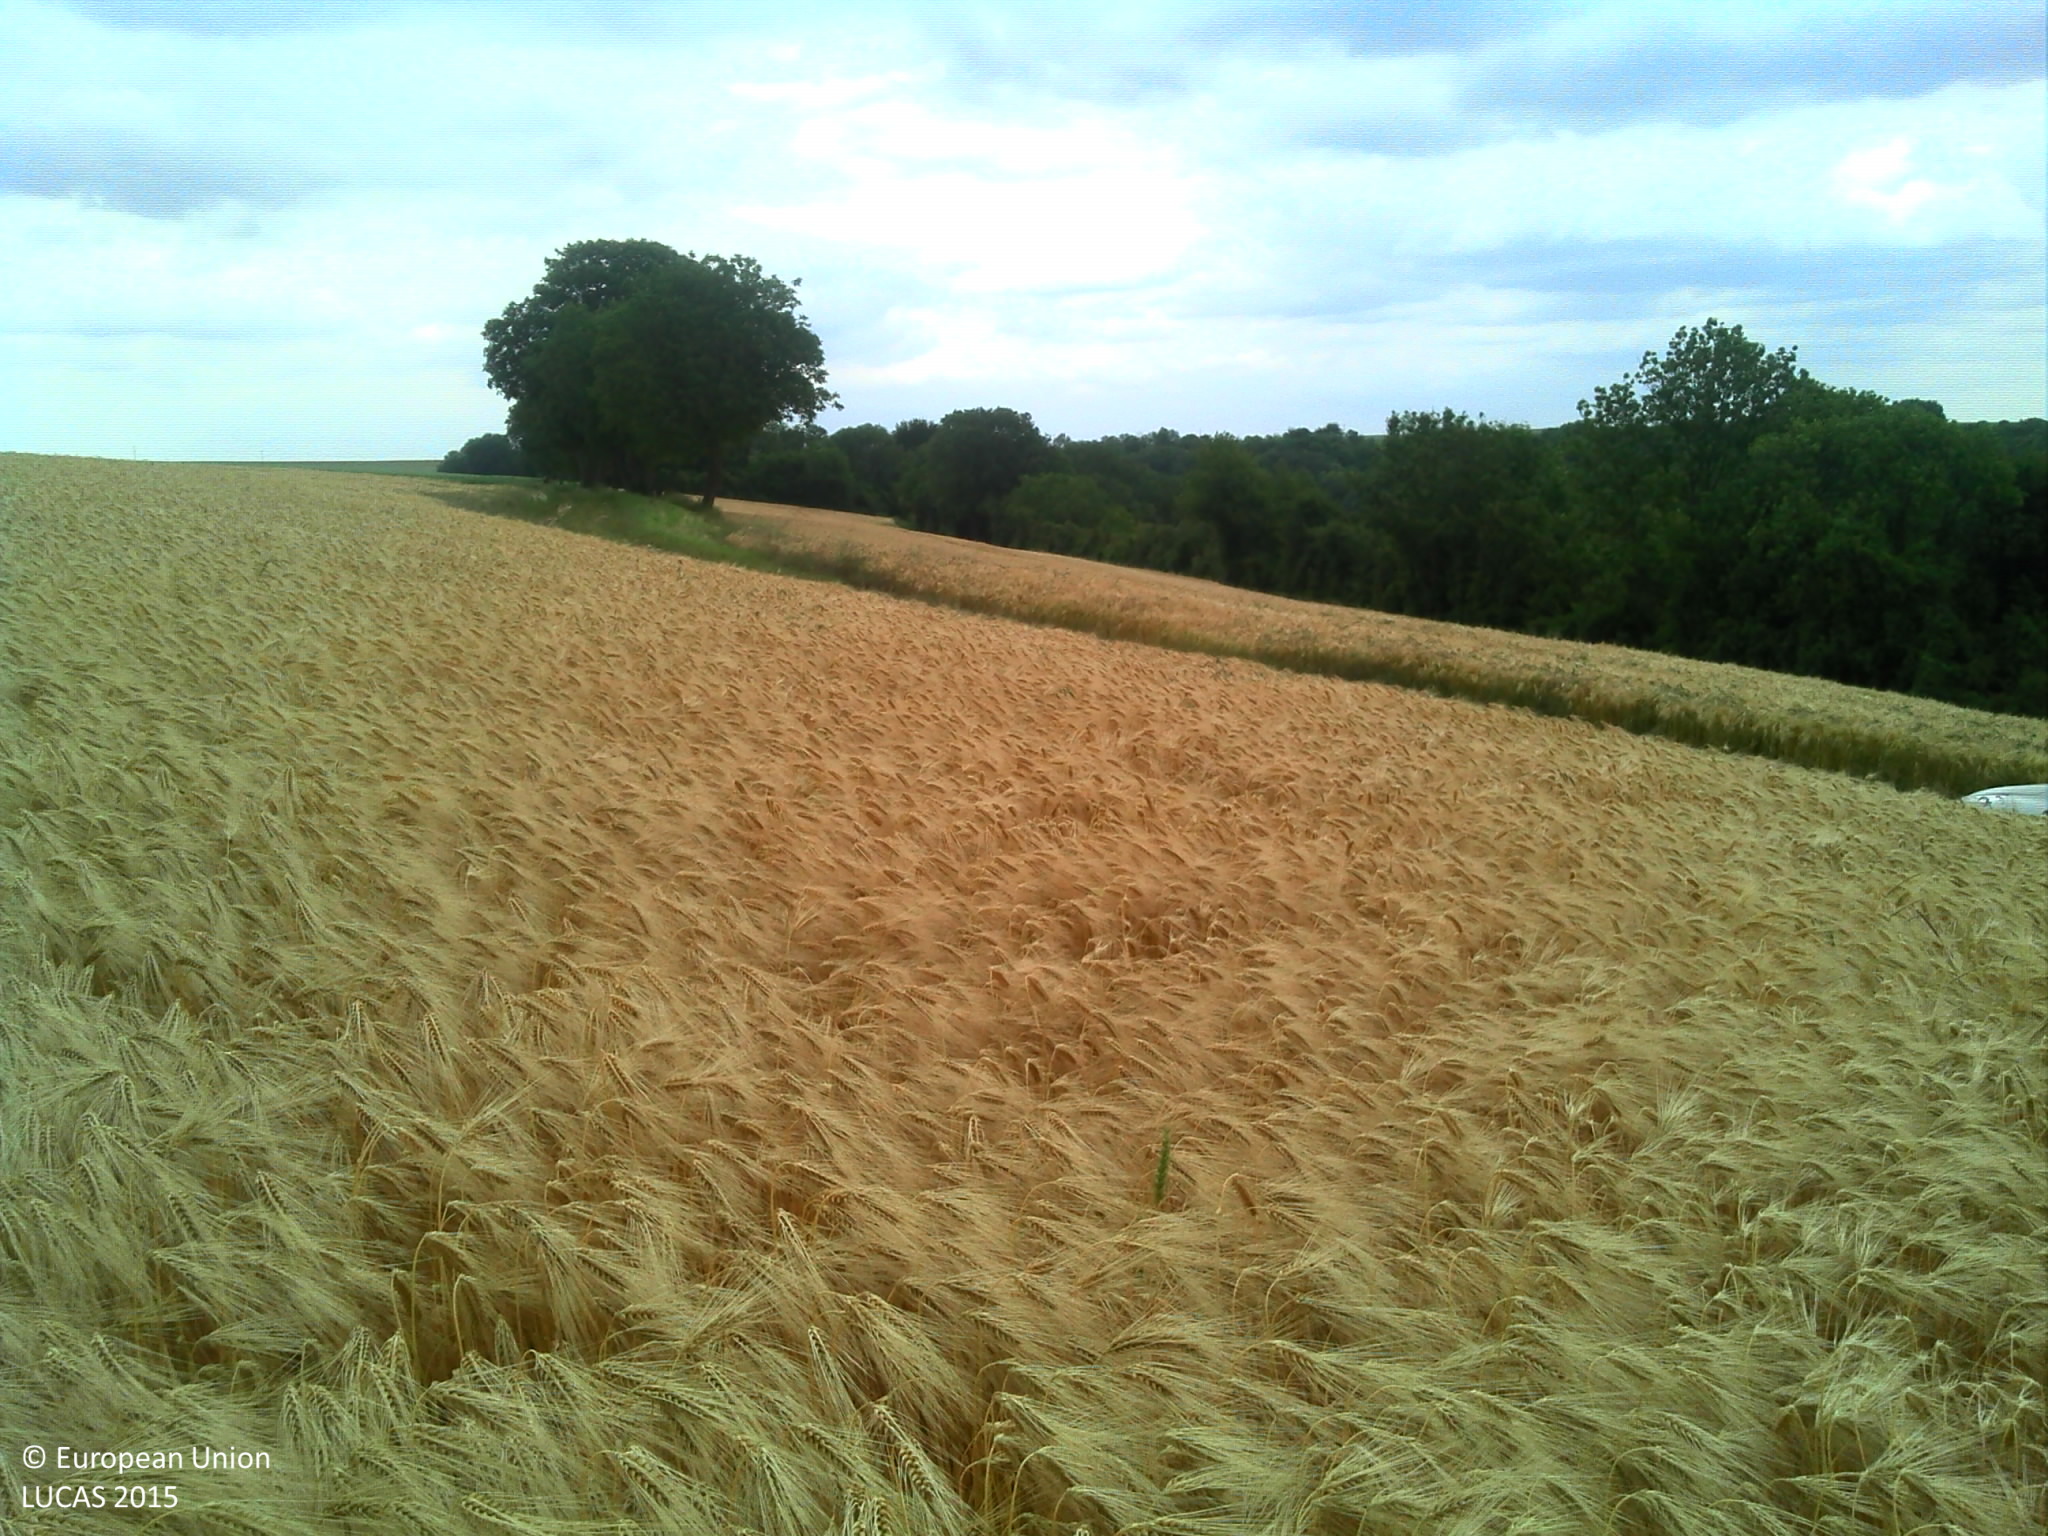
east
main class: Cropland
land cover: Barley
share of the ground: > 75 %
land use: Agriculture (excluding fallow land and kitchen gardens)
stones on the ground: < 10 %
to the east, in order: Barley; Grass margins; Tracks; Barley; Broadleaved woodland; Shrubland with sparse tree cover
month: June
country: FR
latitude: 49.4323
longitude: 3.6921
